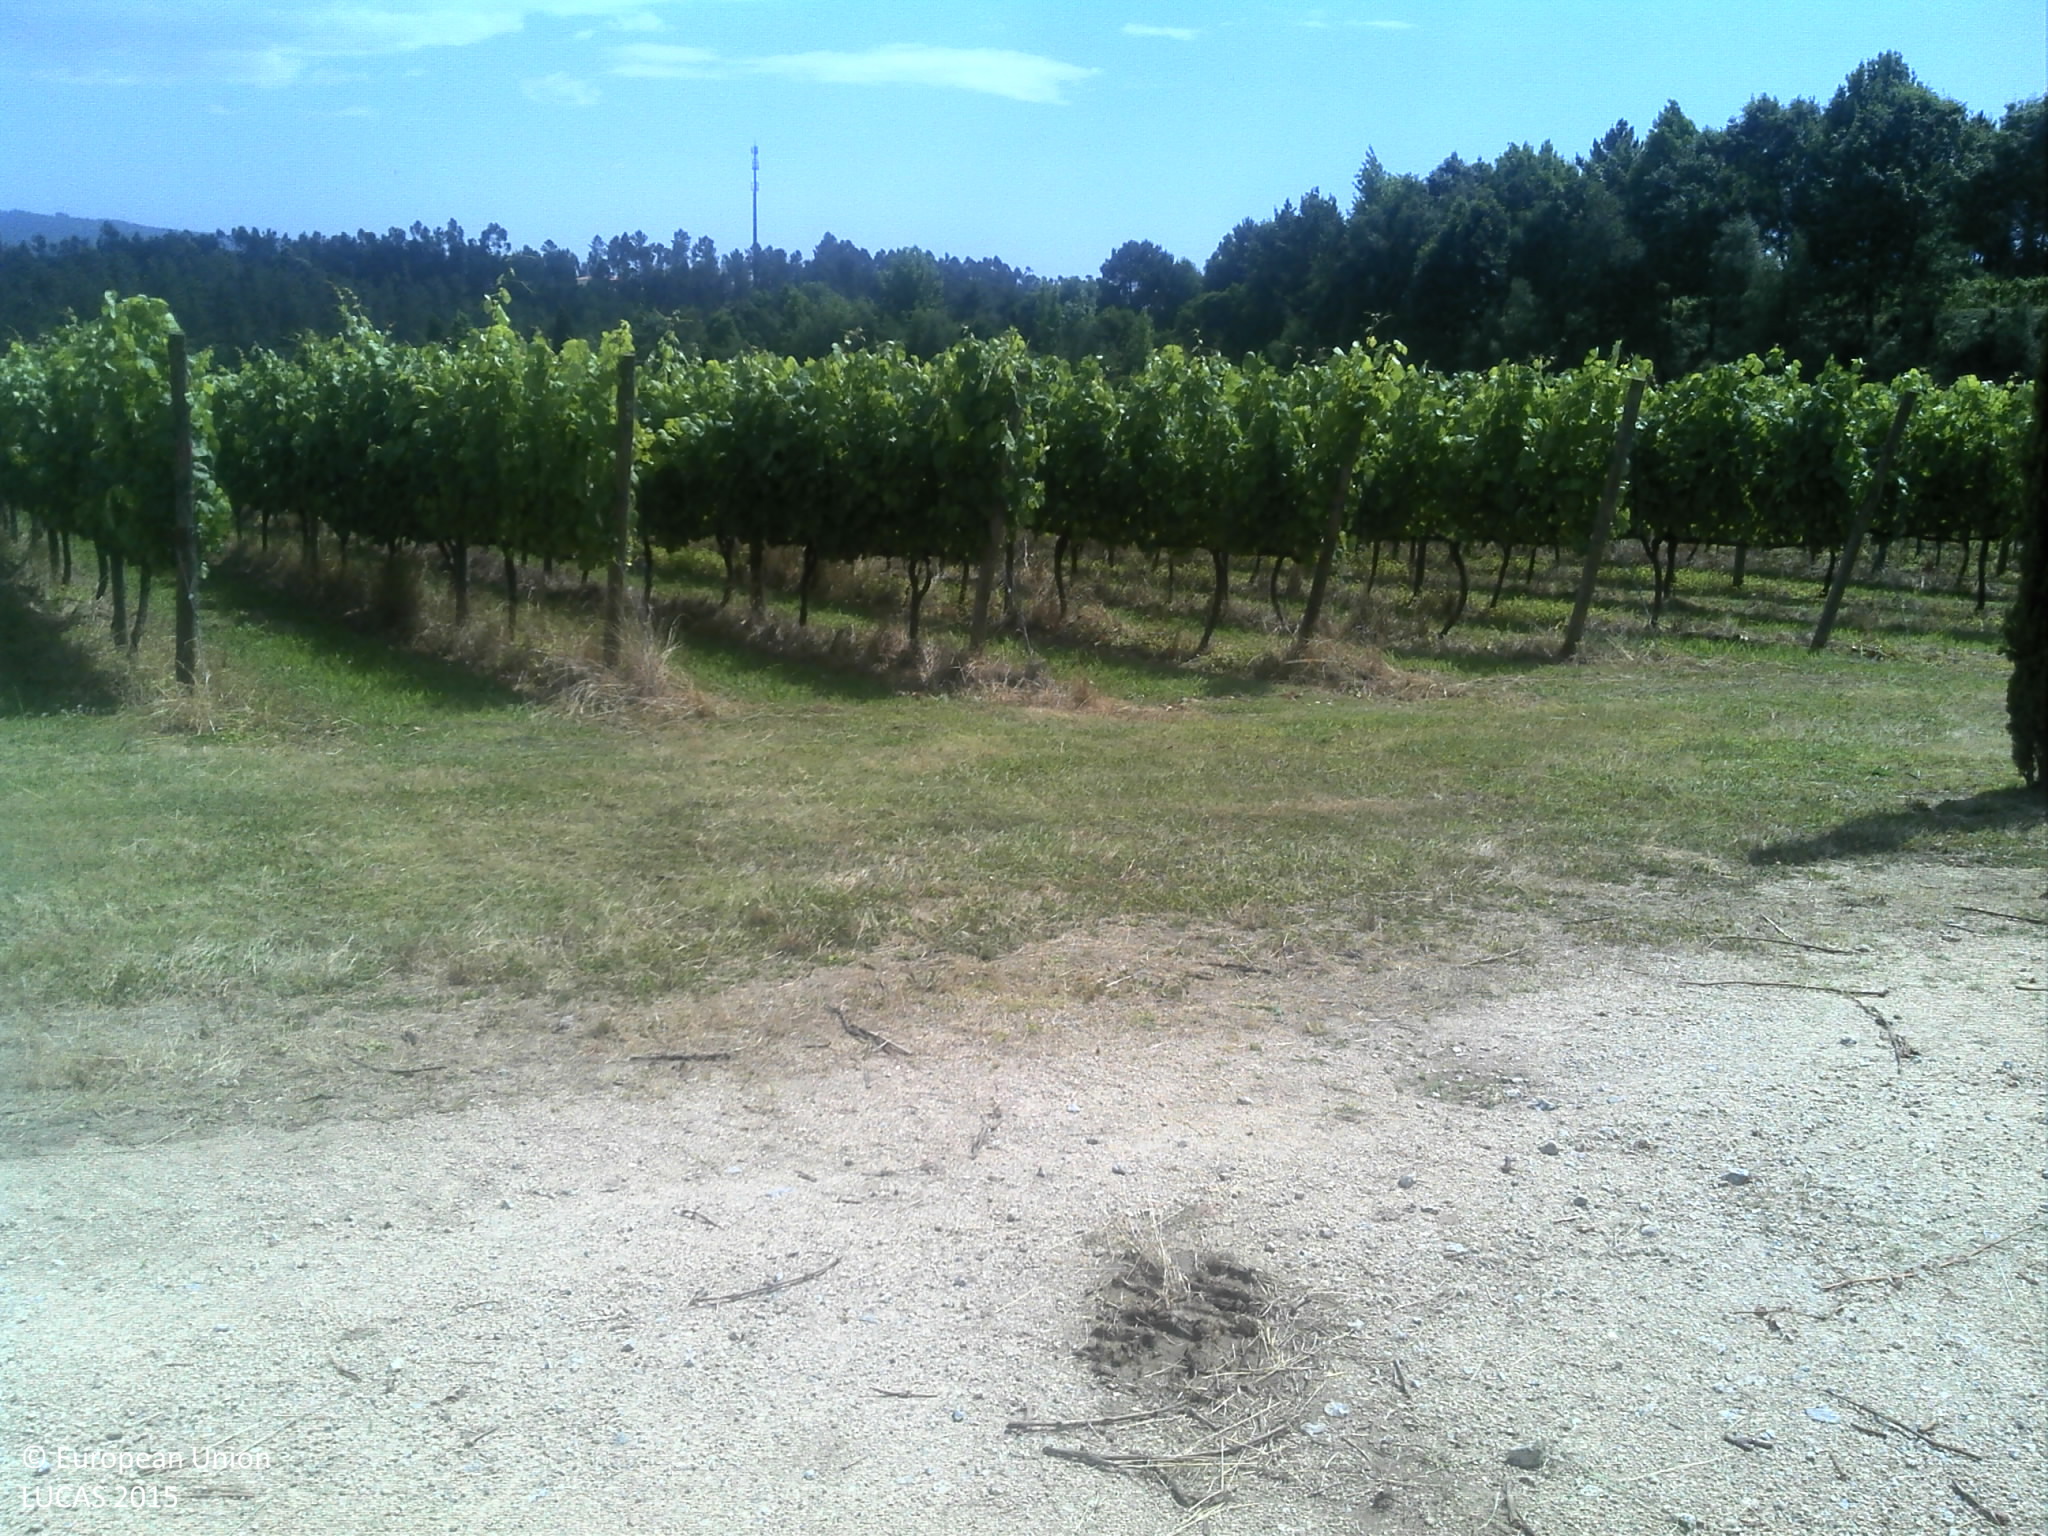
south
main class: Grassland
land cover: Grassland without tree/shrub cover
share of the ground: > 75 %
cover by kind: herbaceous plants 85 %, unconsolidated bare surface 15 %
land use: Agriculture (excluding fallow land and kitchen gardens)
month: June
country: PT
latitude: 41.5710
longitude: -8.5423
